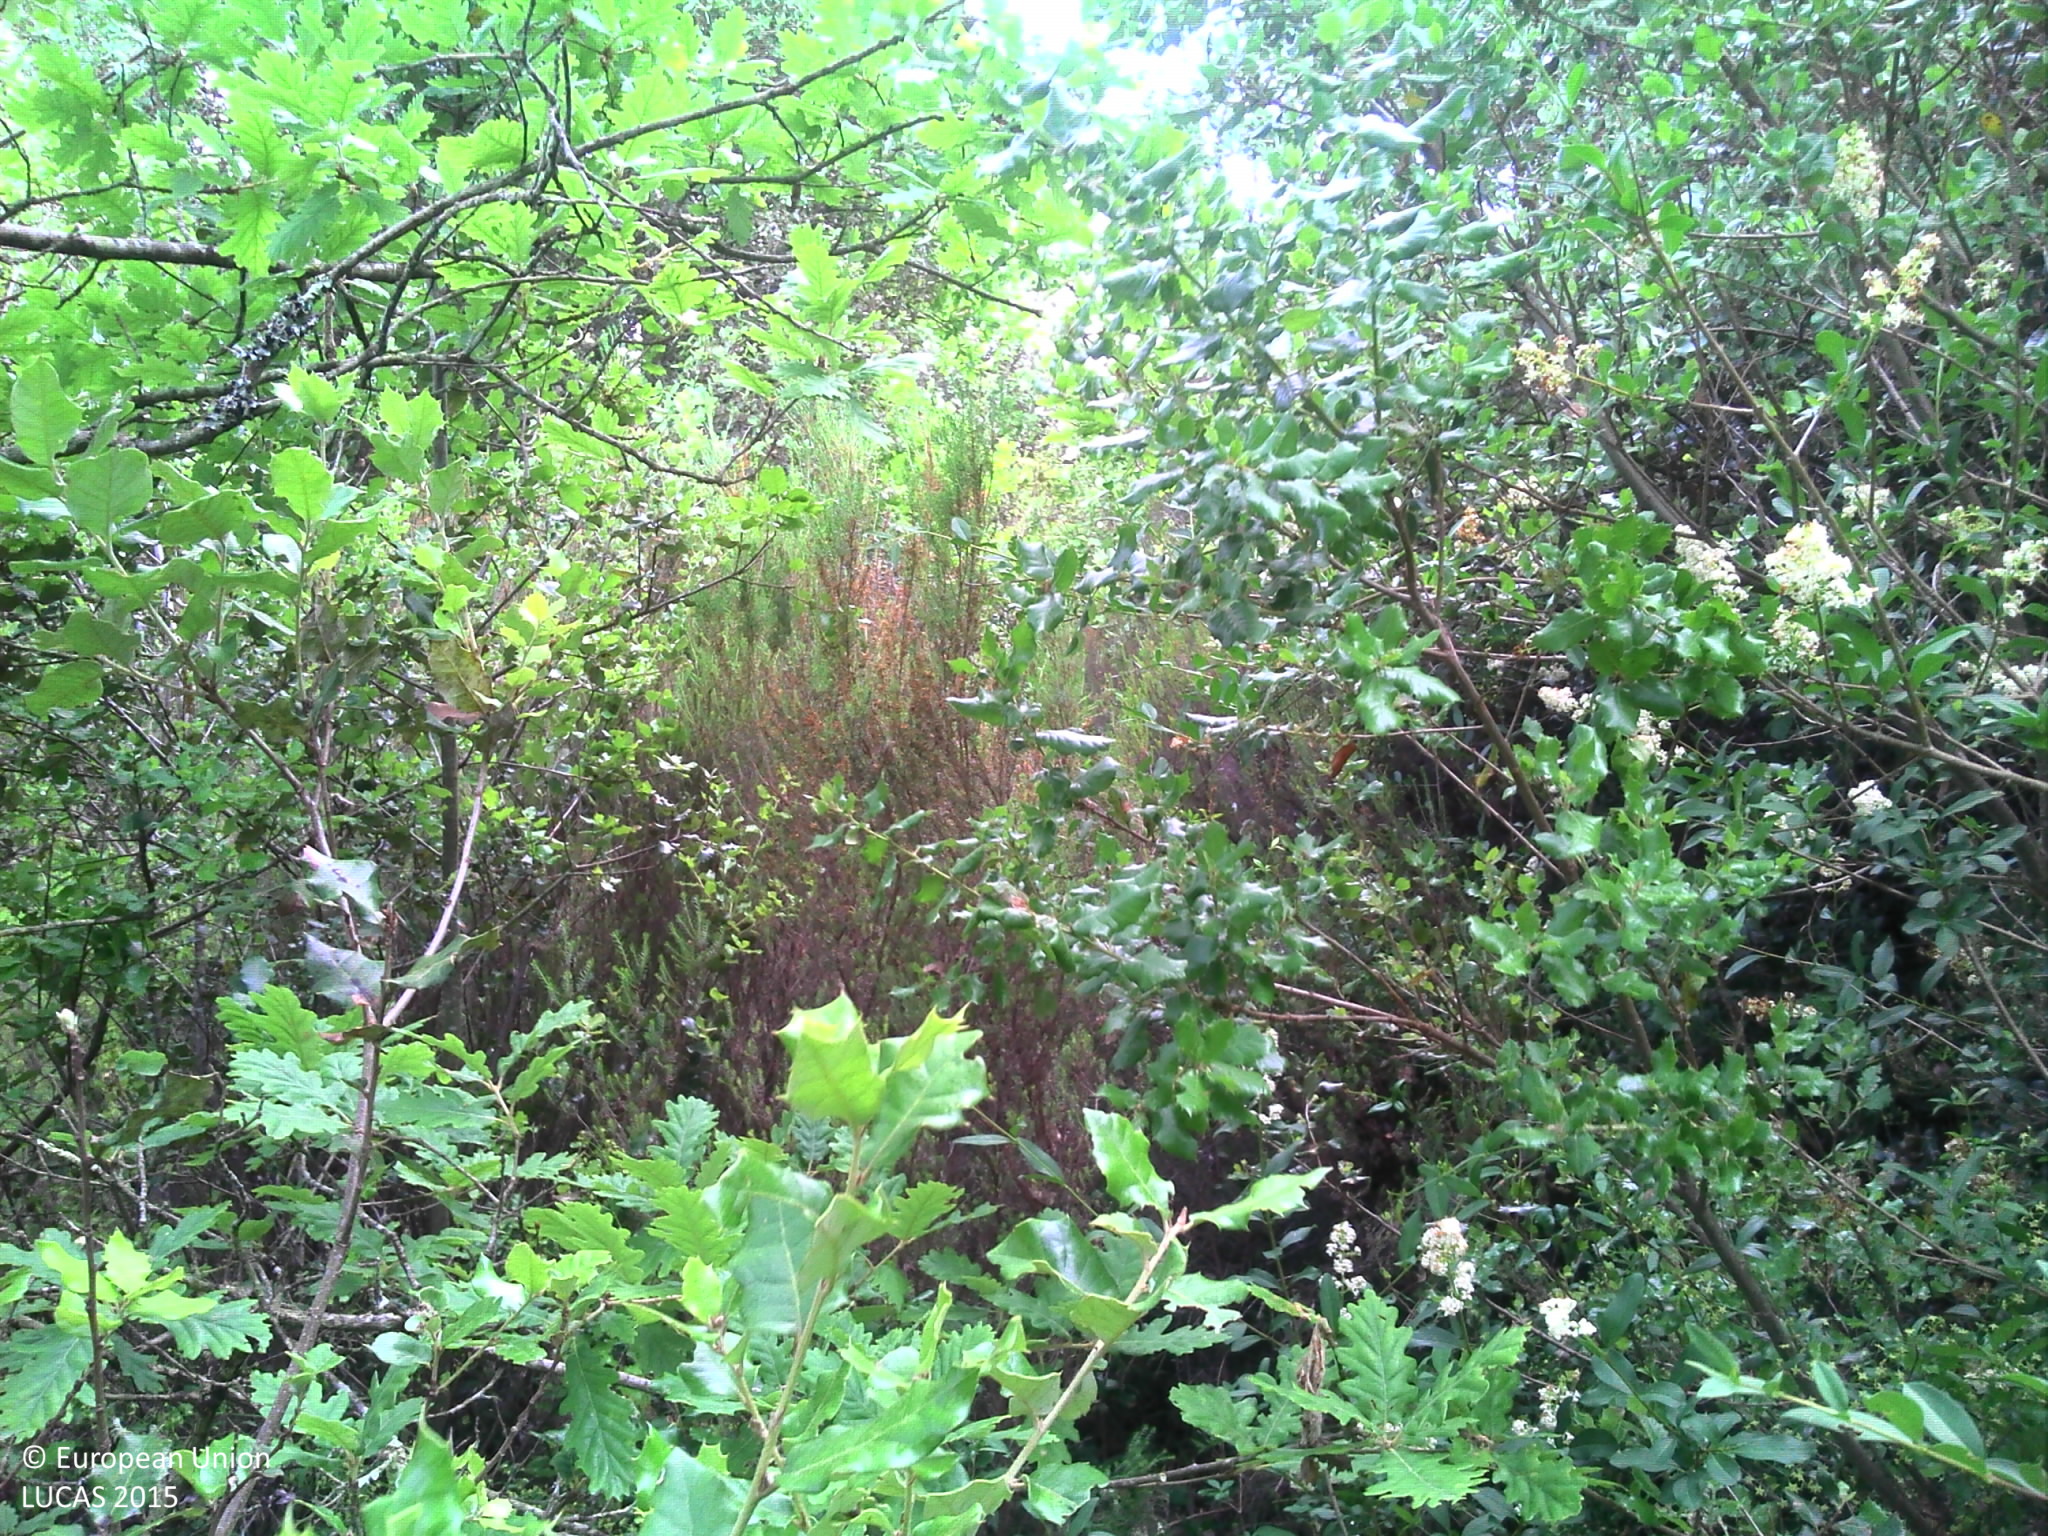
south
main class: Woodland
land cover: Broadleaved woodland
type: beech forest
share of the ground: 25 - 50 %
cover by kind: broadleaved forest trees 100 %
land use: Forestry
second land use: Amenities, museums, leisure
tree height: > 5 m
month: June
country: FR
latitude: 45.9000
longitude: -0.7370
